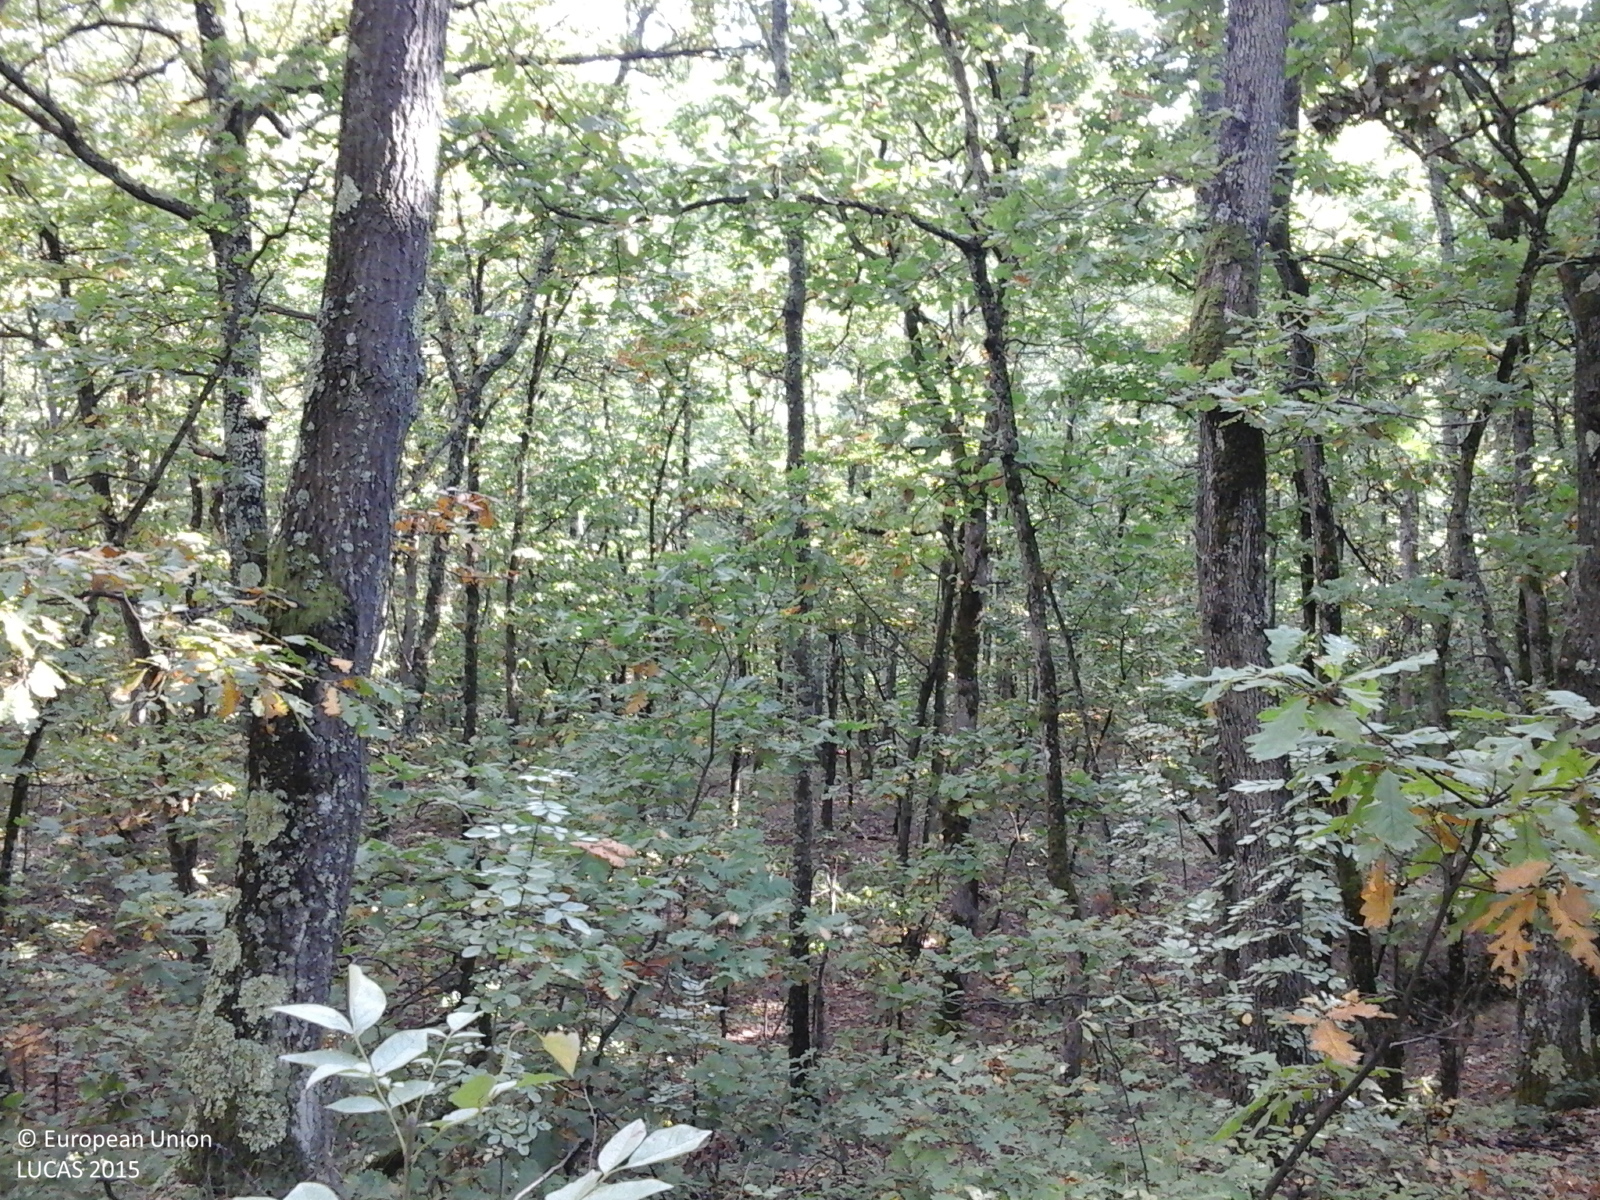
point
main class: Woodland
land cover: Broadleaved woodland
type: acidophilous oak and oak-birch forest
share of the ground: > 75 %
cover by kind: broadleaved forest trees 100 %
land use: Forestry
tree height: > 5 m
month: September
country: RO
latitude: 44.9859
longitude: 23.5912
